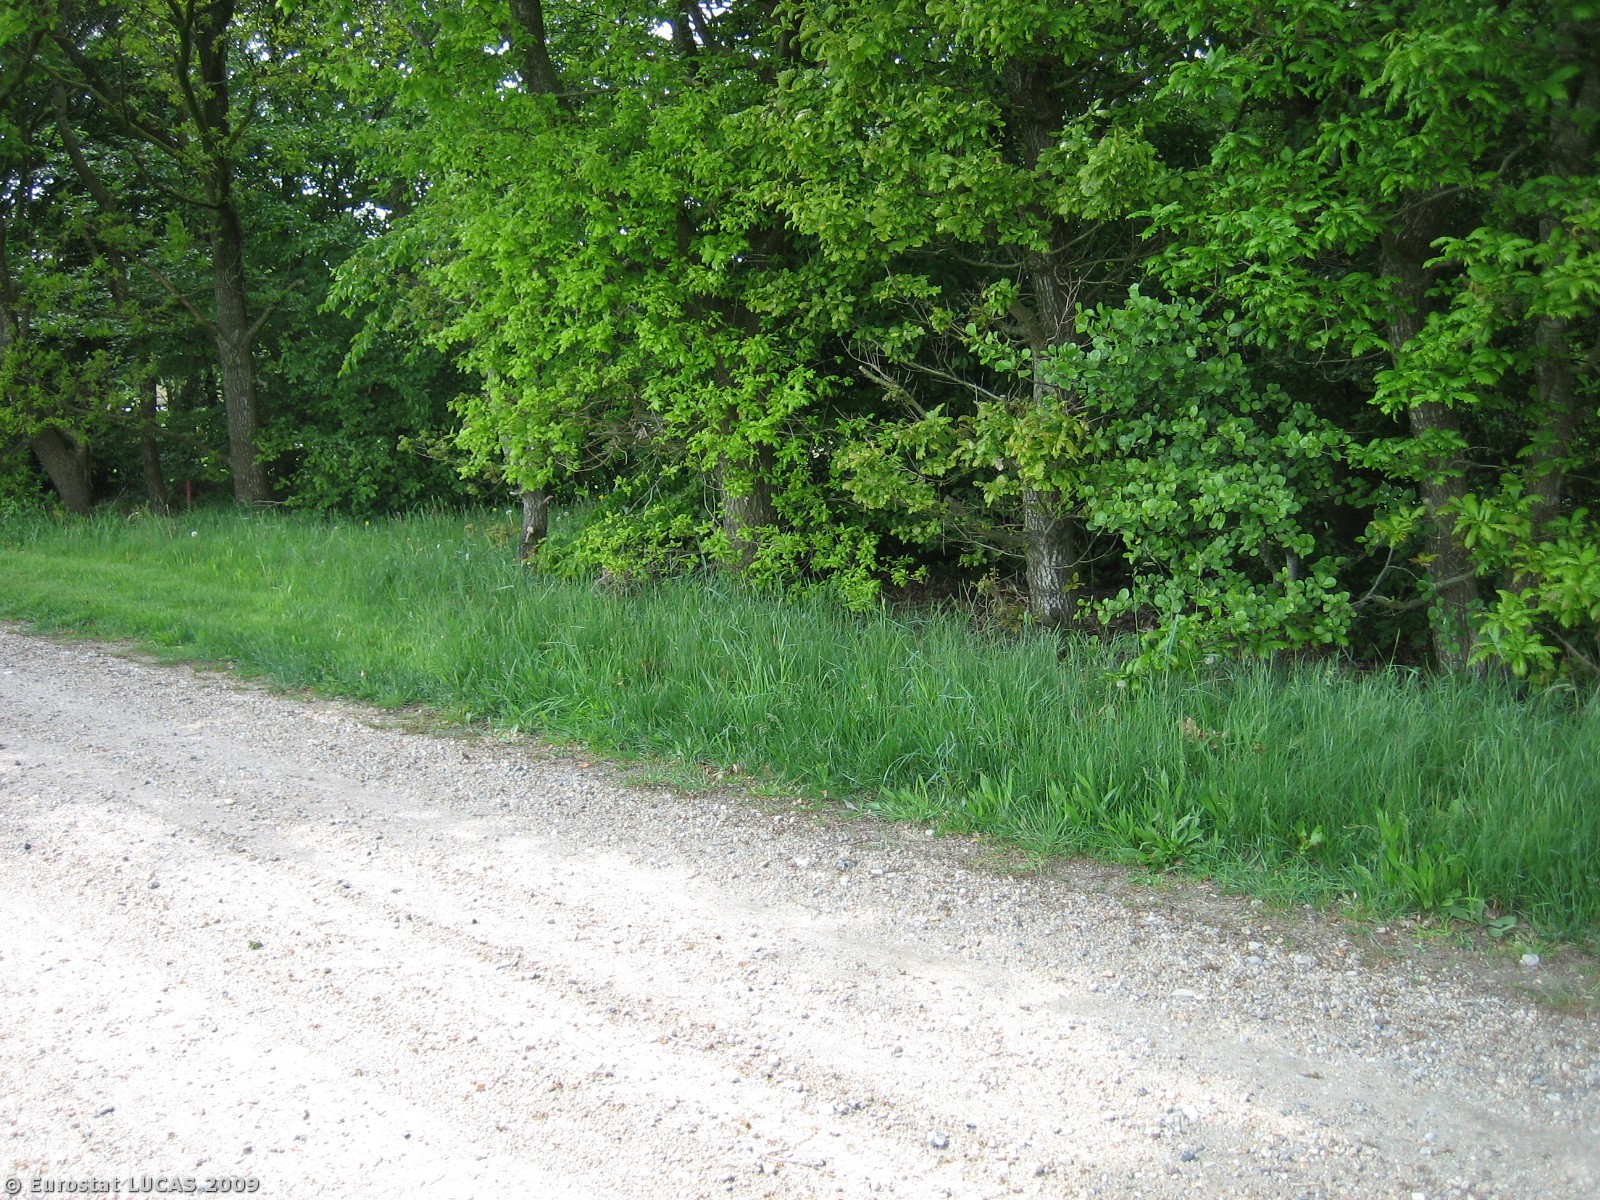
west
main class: Cropland
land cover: Barley
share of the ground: > 75 %
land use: Agriculture (excluding fallow land and kitchen gardens)
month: May
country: DK
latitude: 55.9661
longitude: 8.7677
